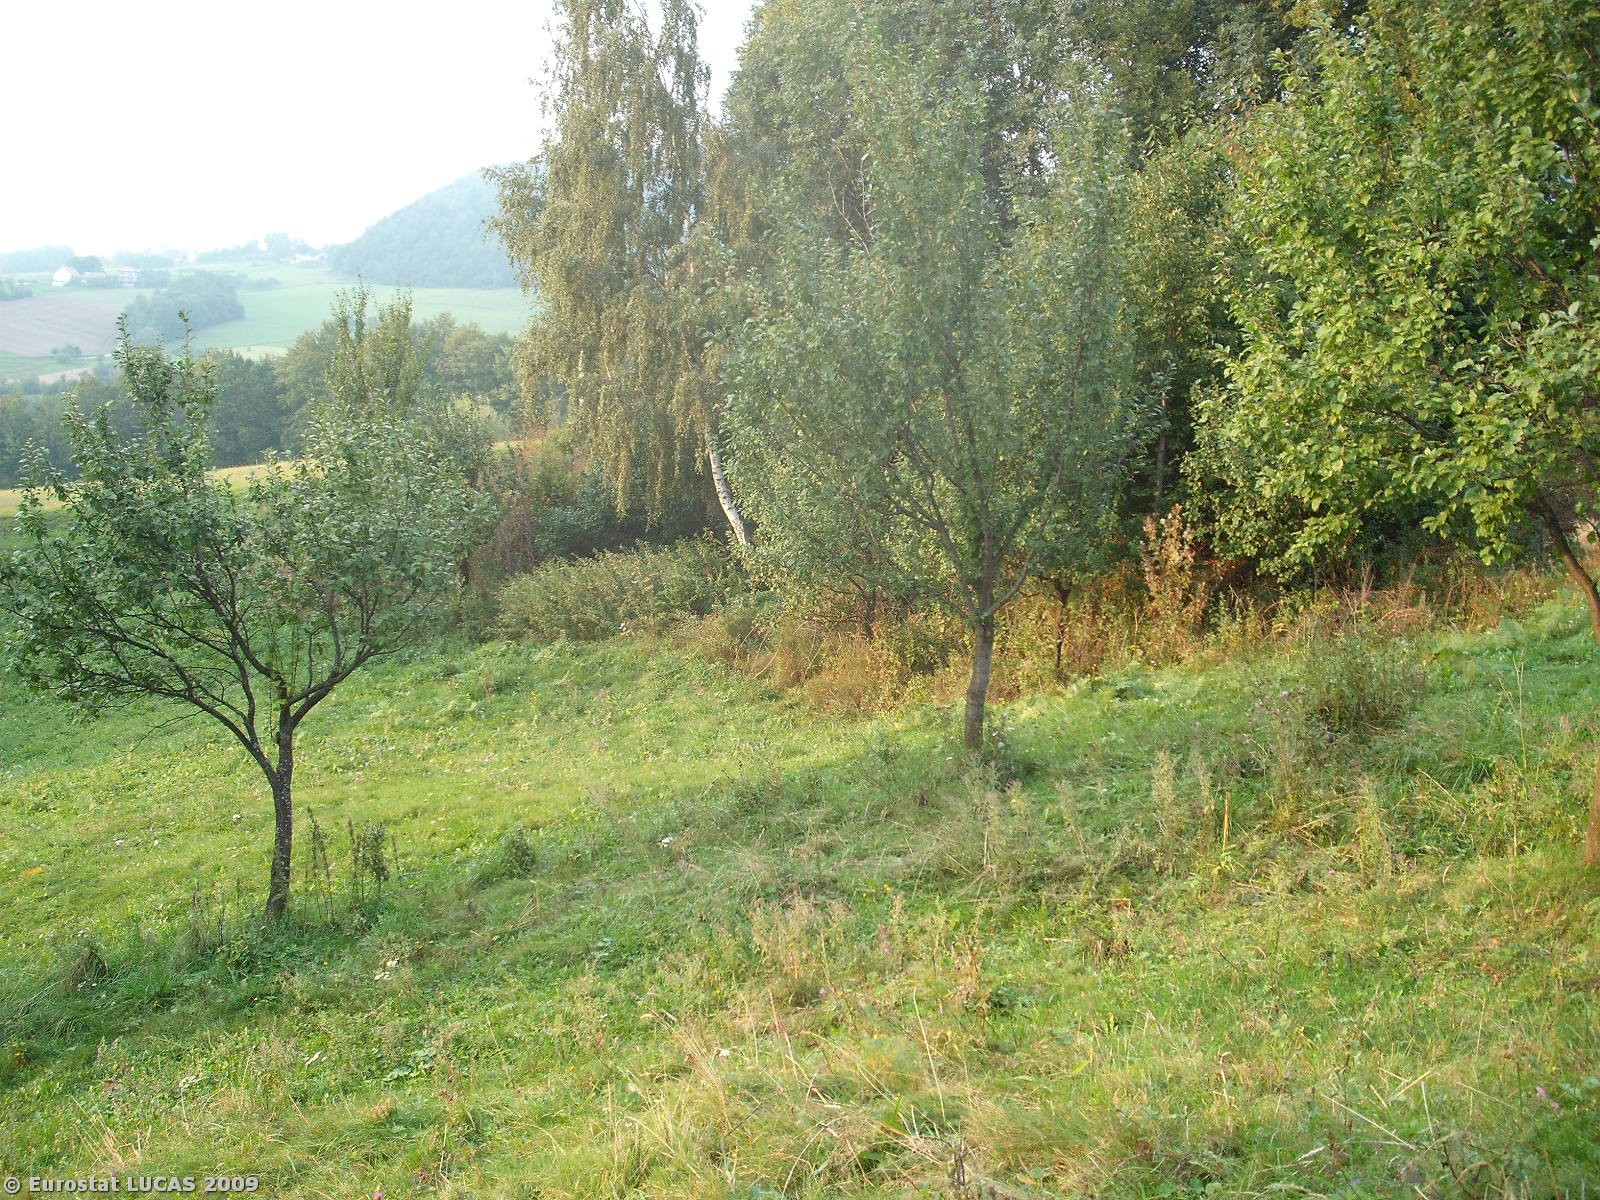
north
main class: Grassland
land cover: Grassland with sparse tree/shrub cover
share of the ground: > 75 %
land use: Agriculture (excluding fallow land and kitchen gardens)
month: September
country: PL
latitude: 49.6290
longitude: 20.4616
